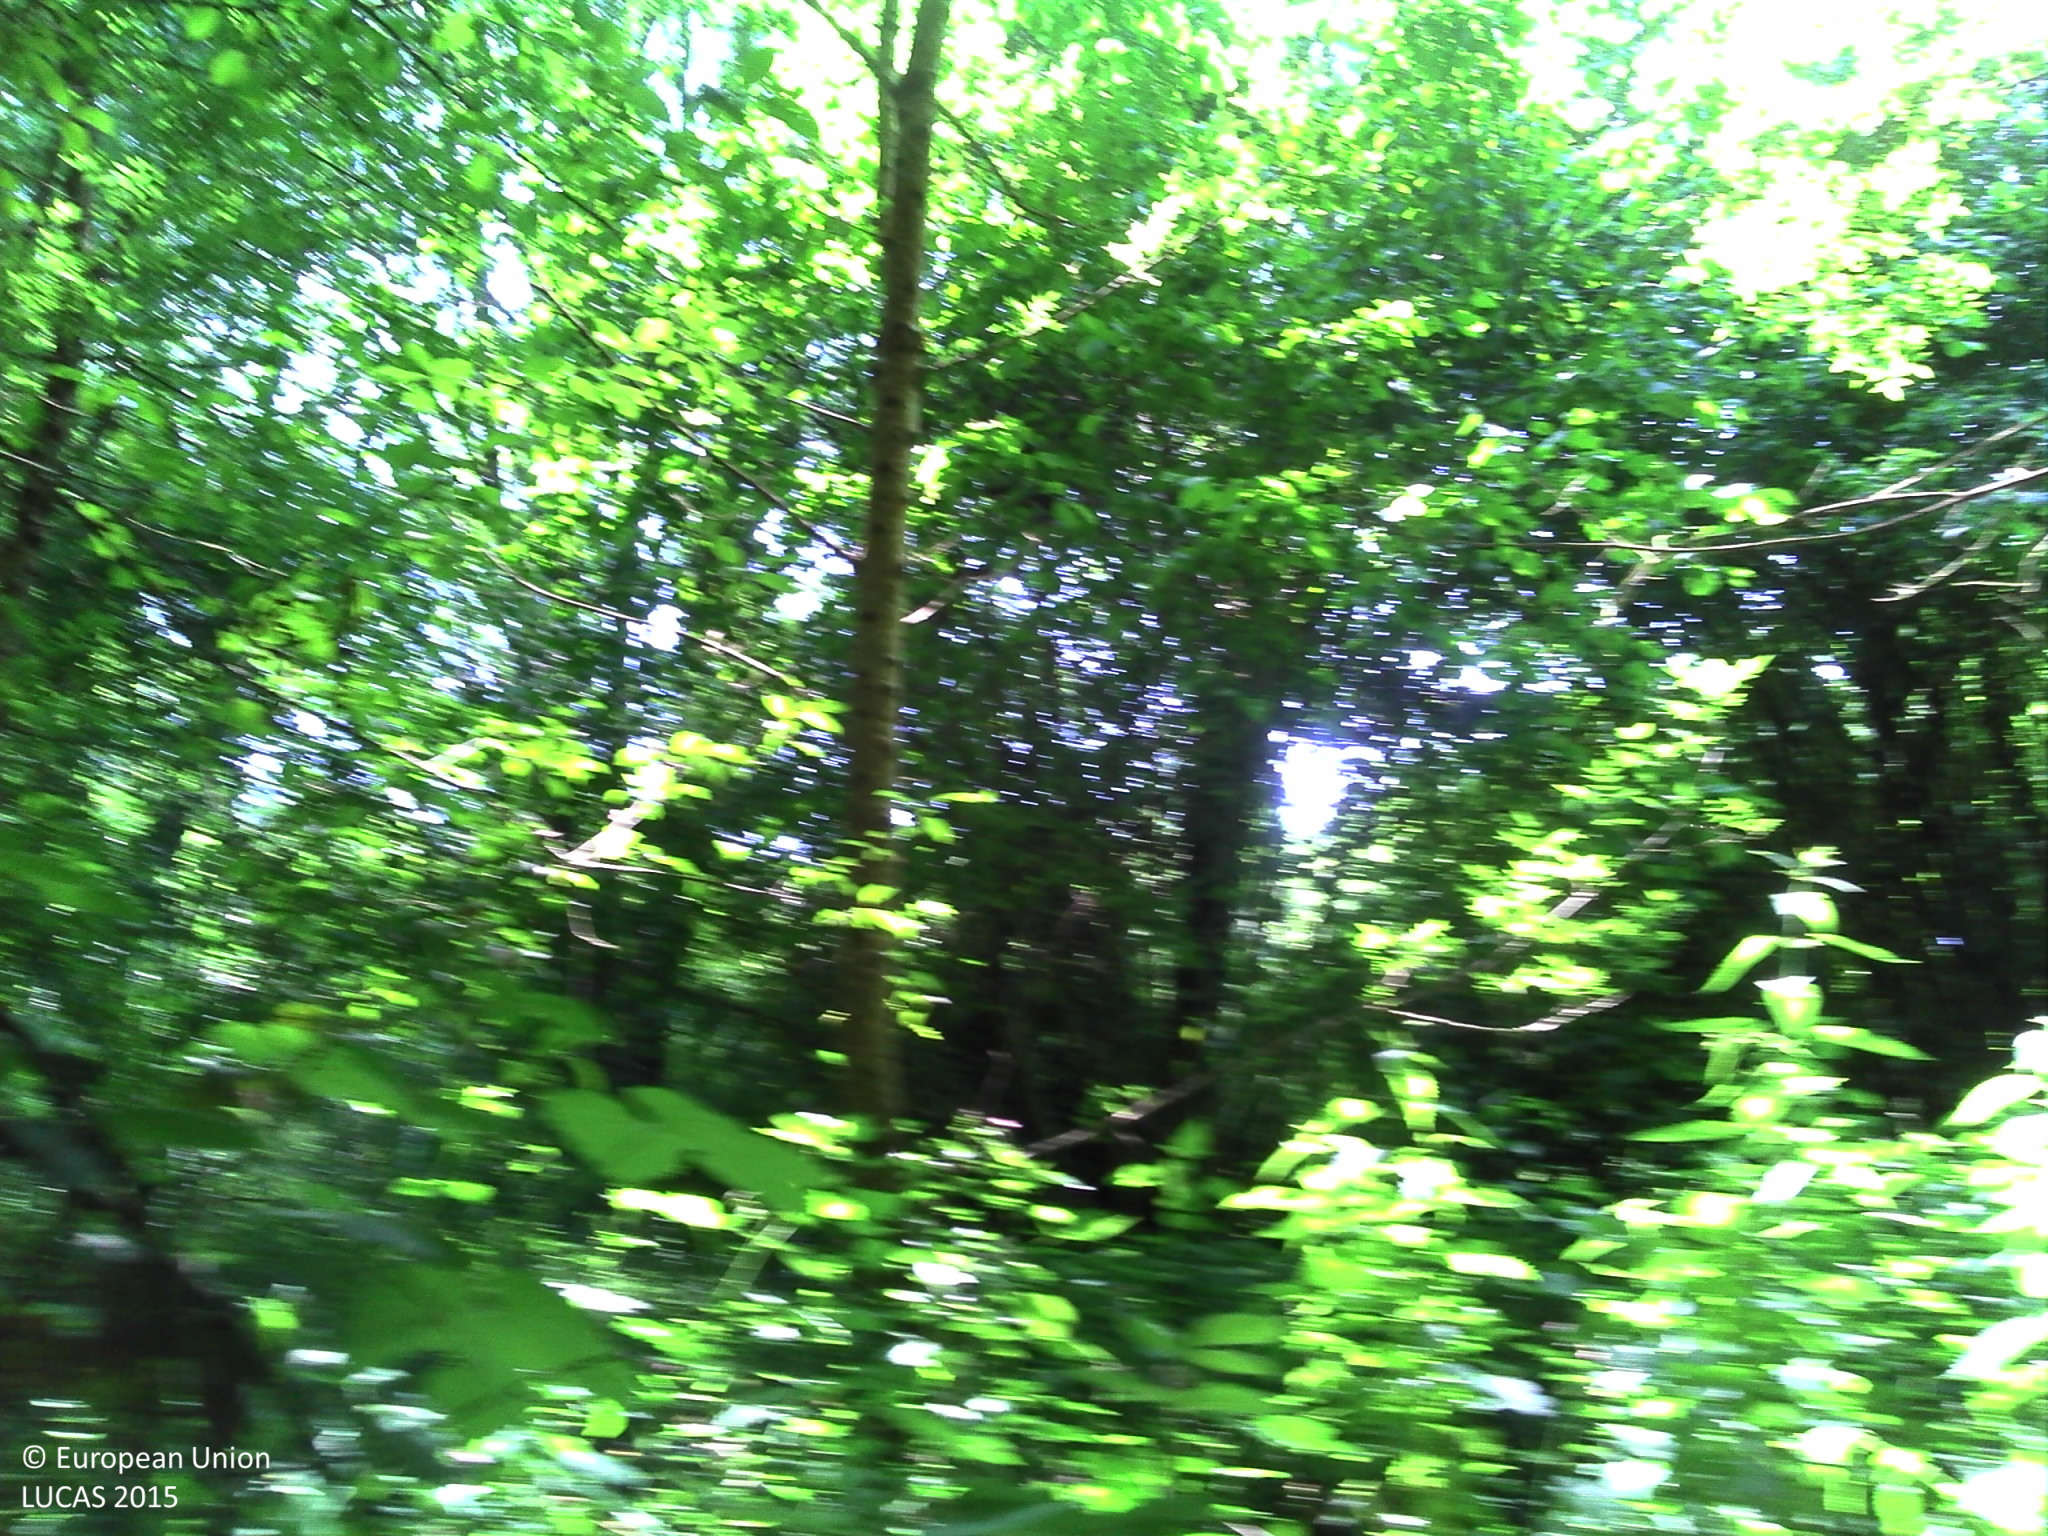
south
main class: Woodland
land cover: Broadleaved woodland
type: floodplain forest
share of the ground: > 75 %
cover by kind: broadleaved forest trees 95 %, herbaceous plants 5 %
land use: Semi-natural and natural areas not in use
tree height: > 5 m
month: June
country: FR
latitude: 47.1374
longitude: -1.4186
